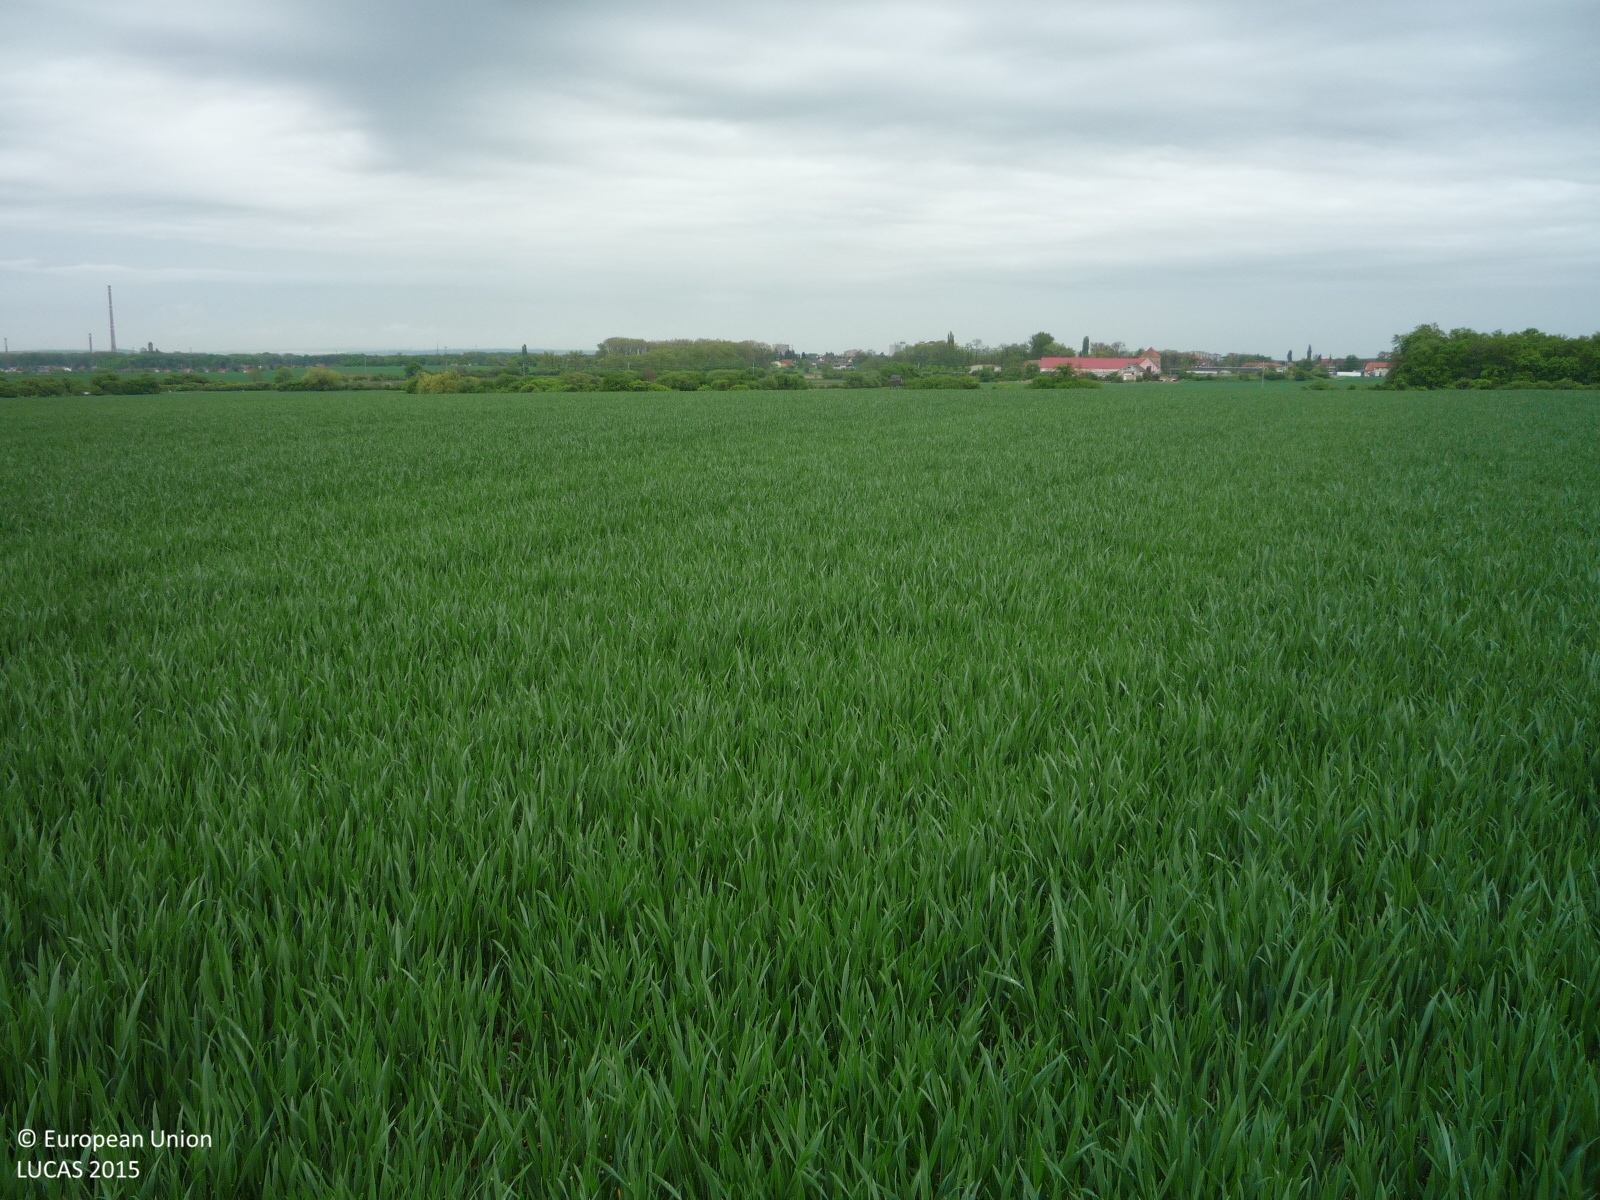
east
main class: Cropland
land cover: Common wheat
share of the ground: > 75 %
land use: Agriculture (excluding fallow land and kitchen gardens)
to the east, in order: Common wheat
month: May
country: CZ
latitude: 50.2585
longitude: 14.4762
